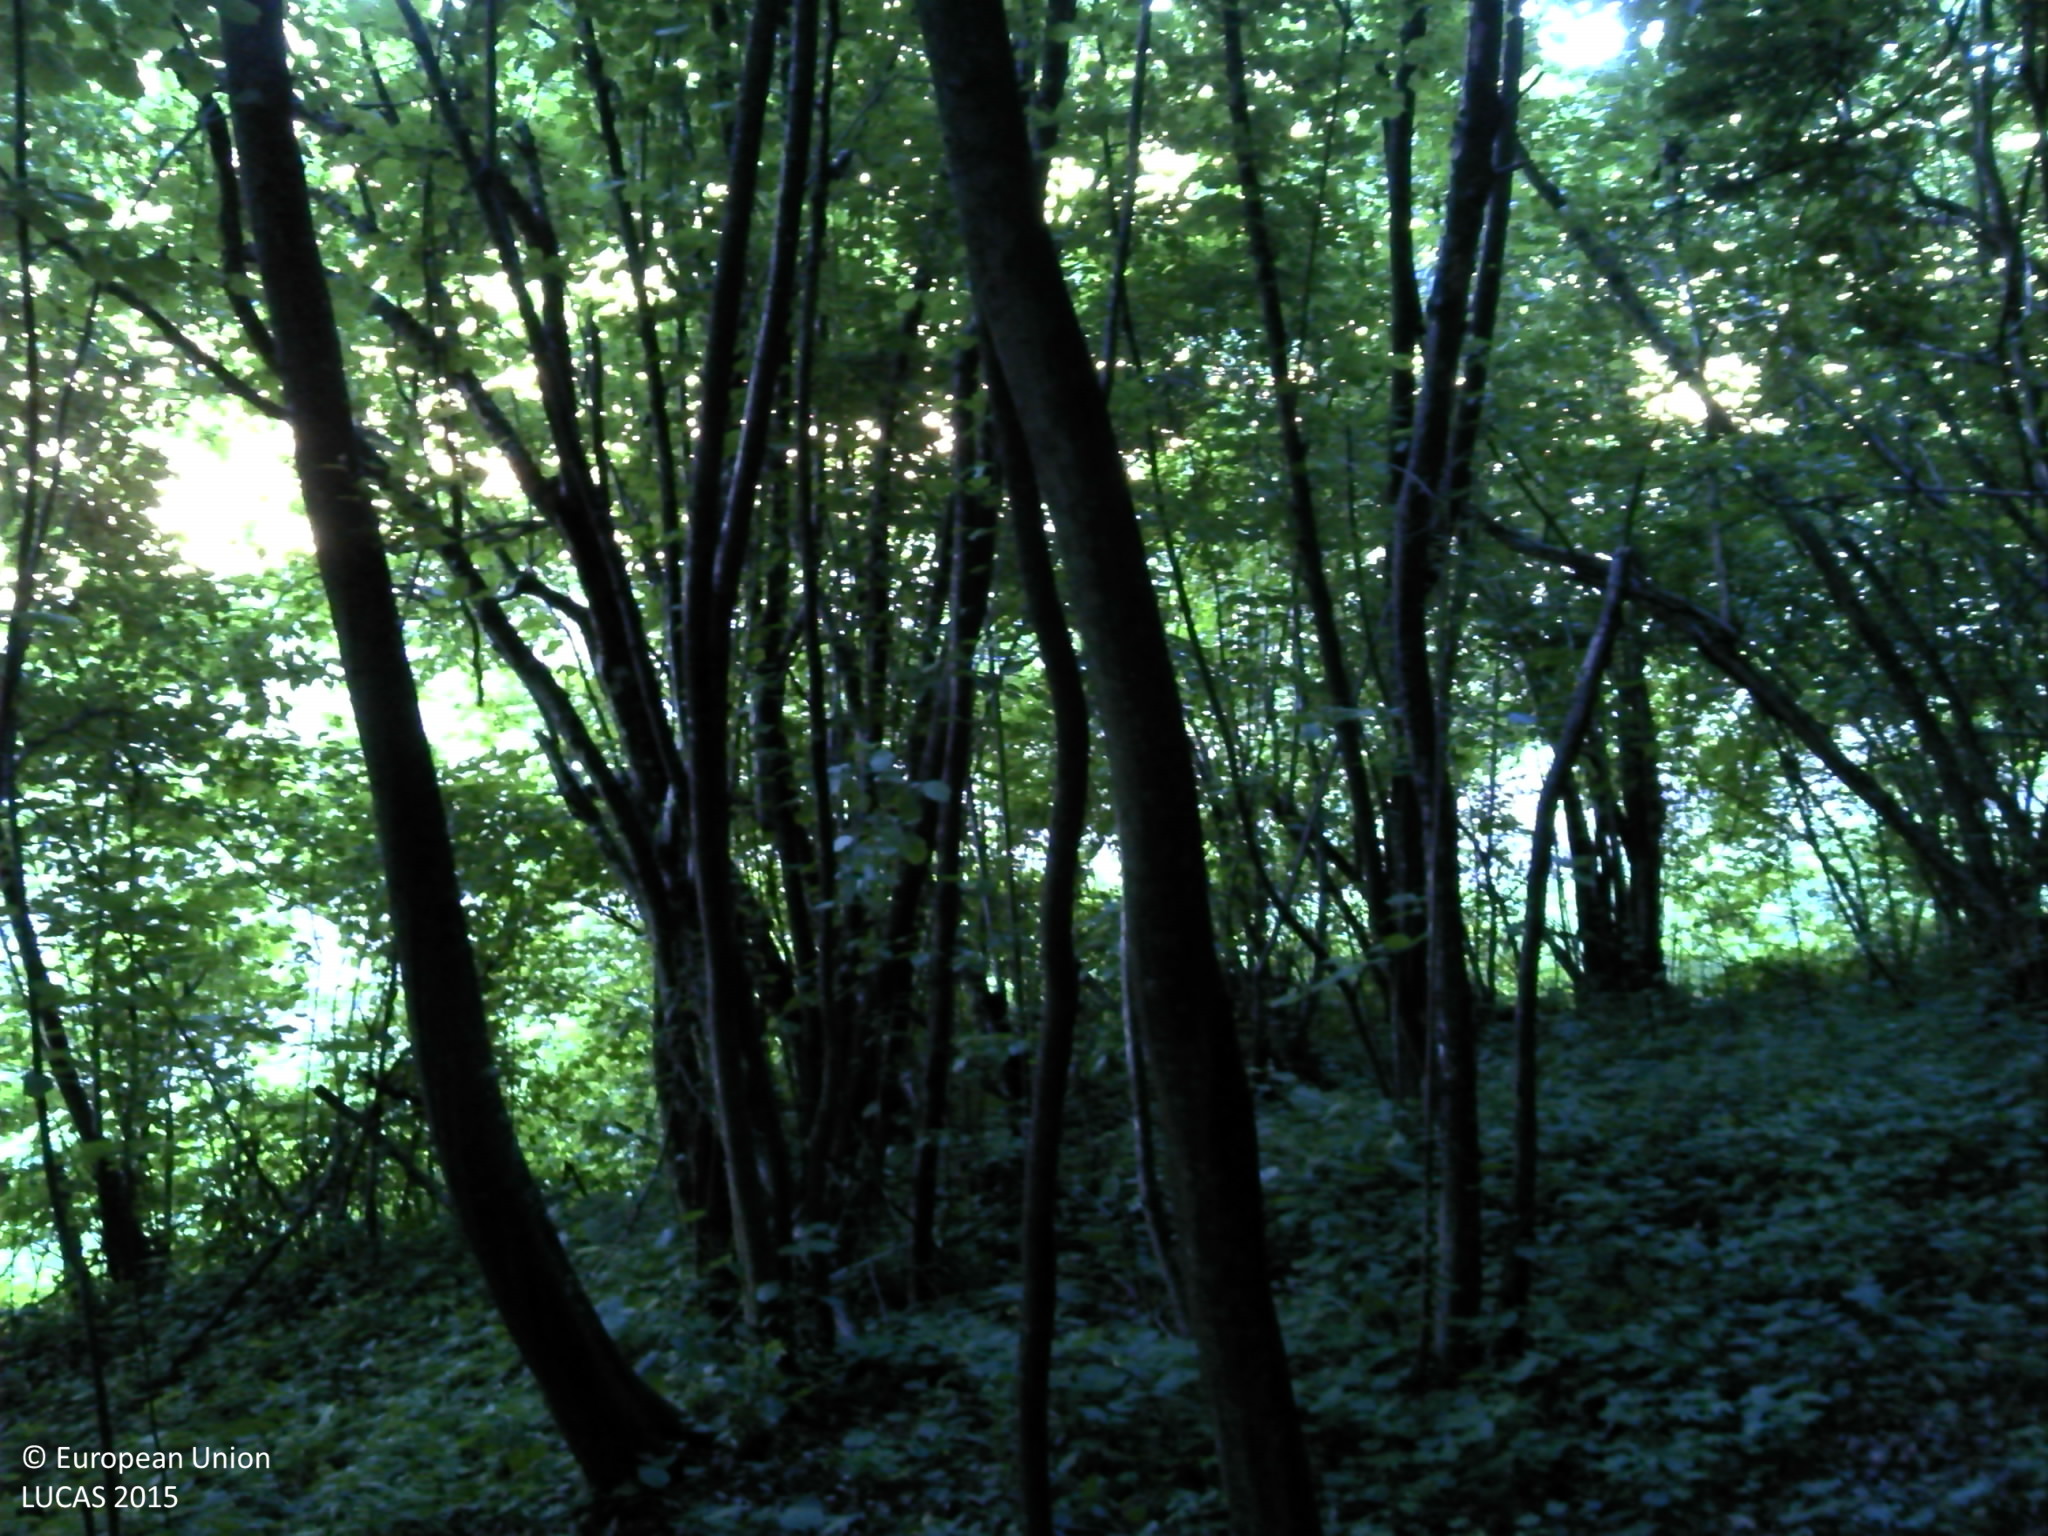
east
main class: Woodland
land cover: Broadleaved woodland
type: beech forest
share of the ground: > 75 %
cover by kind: broadleaved forest trees 100 %
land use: Forestry
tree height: < 5 m
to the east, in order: Broadleaved woodland; Maize; Shrubland with sparse tree cover; Ditches and canals; Shrubland with sparse tree cover; Maize; Grassland with sparse tree/shrub cover
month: May
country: HR
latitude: 45.3270
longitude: 18.0027
